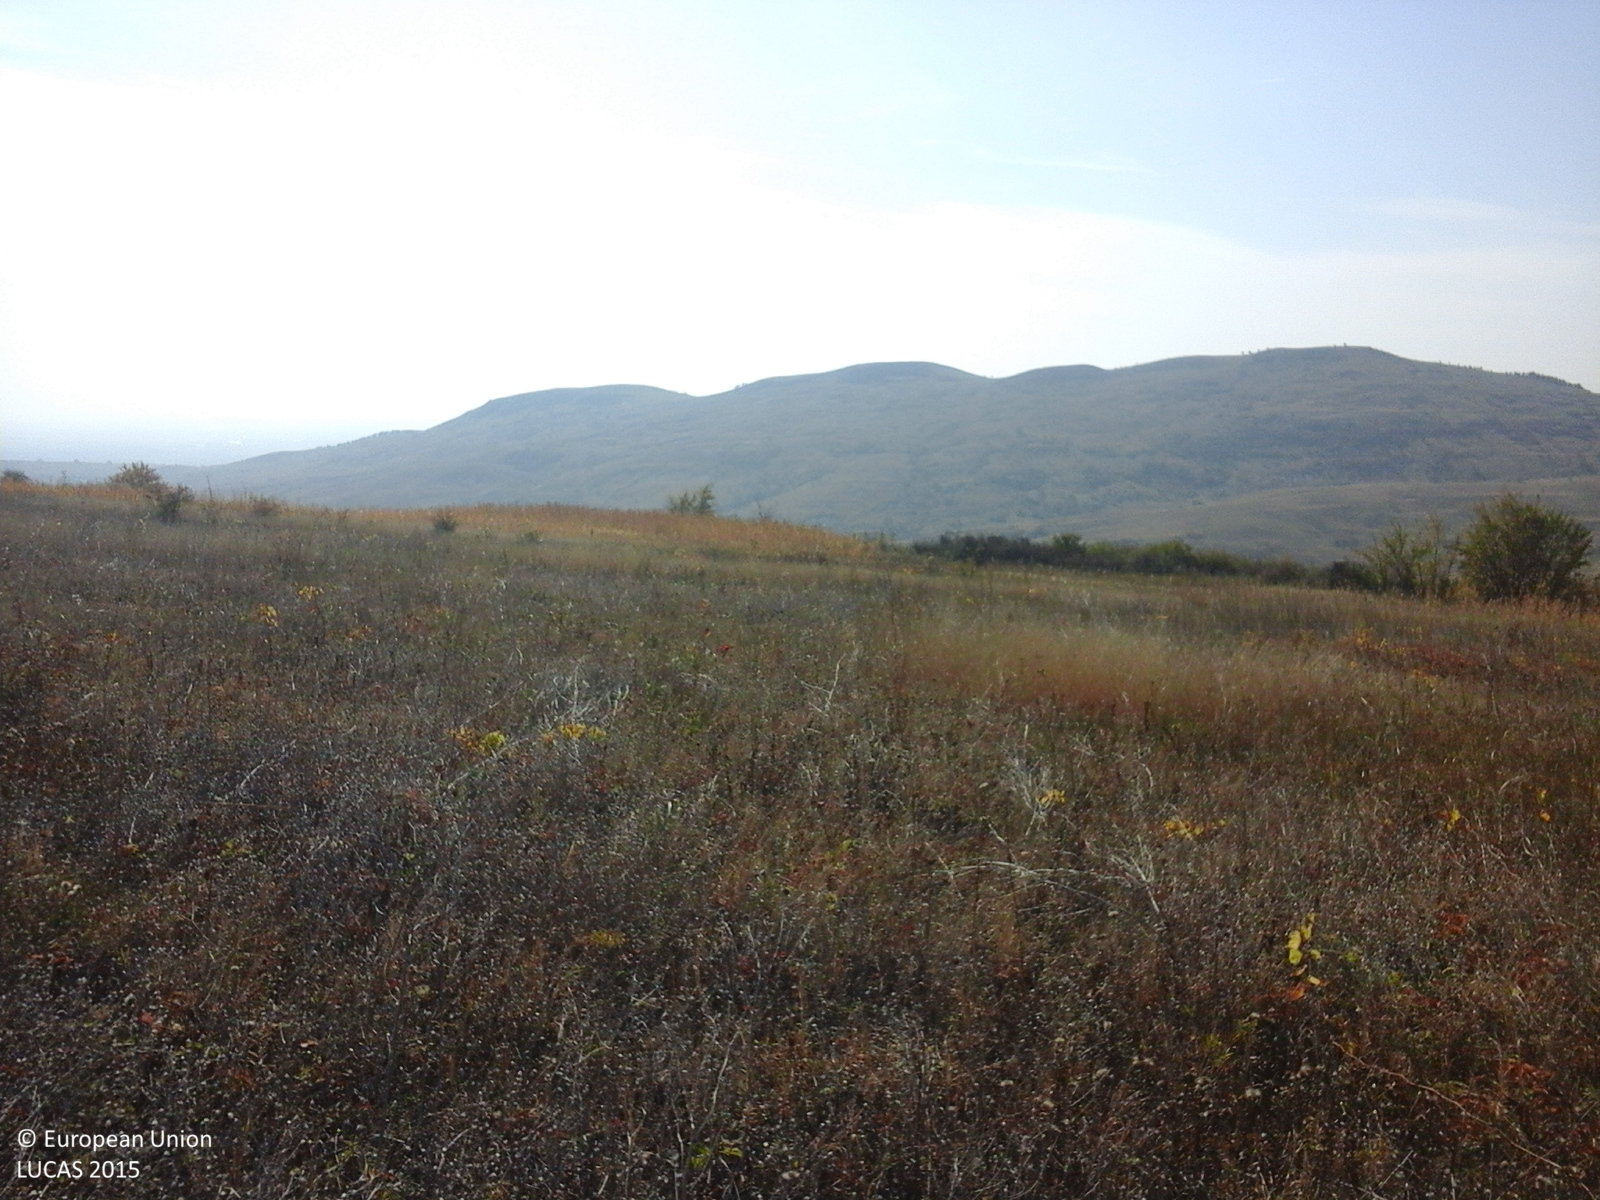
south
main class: Grassland
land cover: Grassland without tree/shrub cover
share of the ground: > 75 %
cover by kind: herbaceous plants 100 %
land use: Agriculture (excluding fallow land and kitchen gardens)
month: October
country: RO
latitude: 45.0855
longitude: 26.4458
